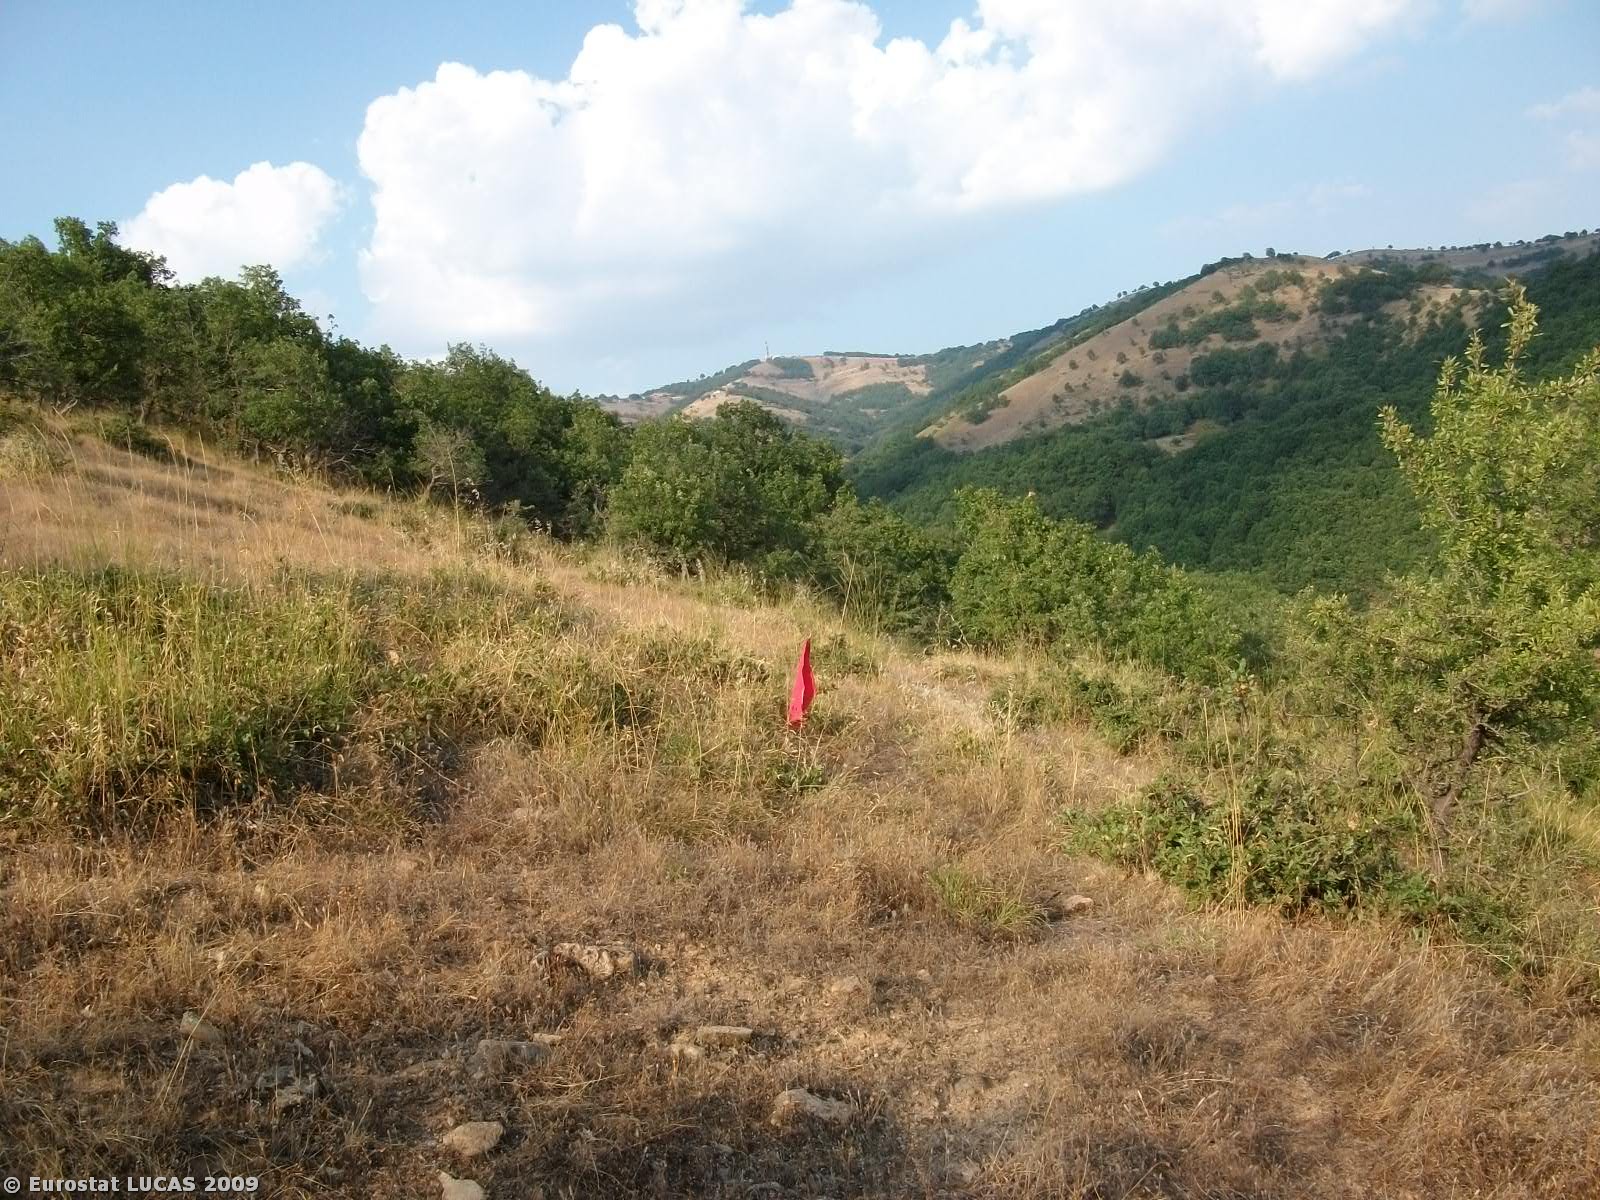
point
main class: Grassland
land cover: Grassland with sparse tree/shrub cover
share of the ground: > 75 %
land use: Unused
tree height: > 5 m
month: August
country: GR
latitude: 39.7541
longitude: 21.6445
